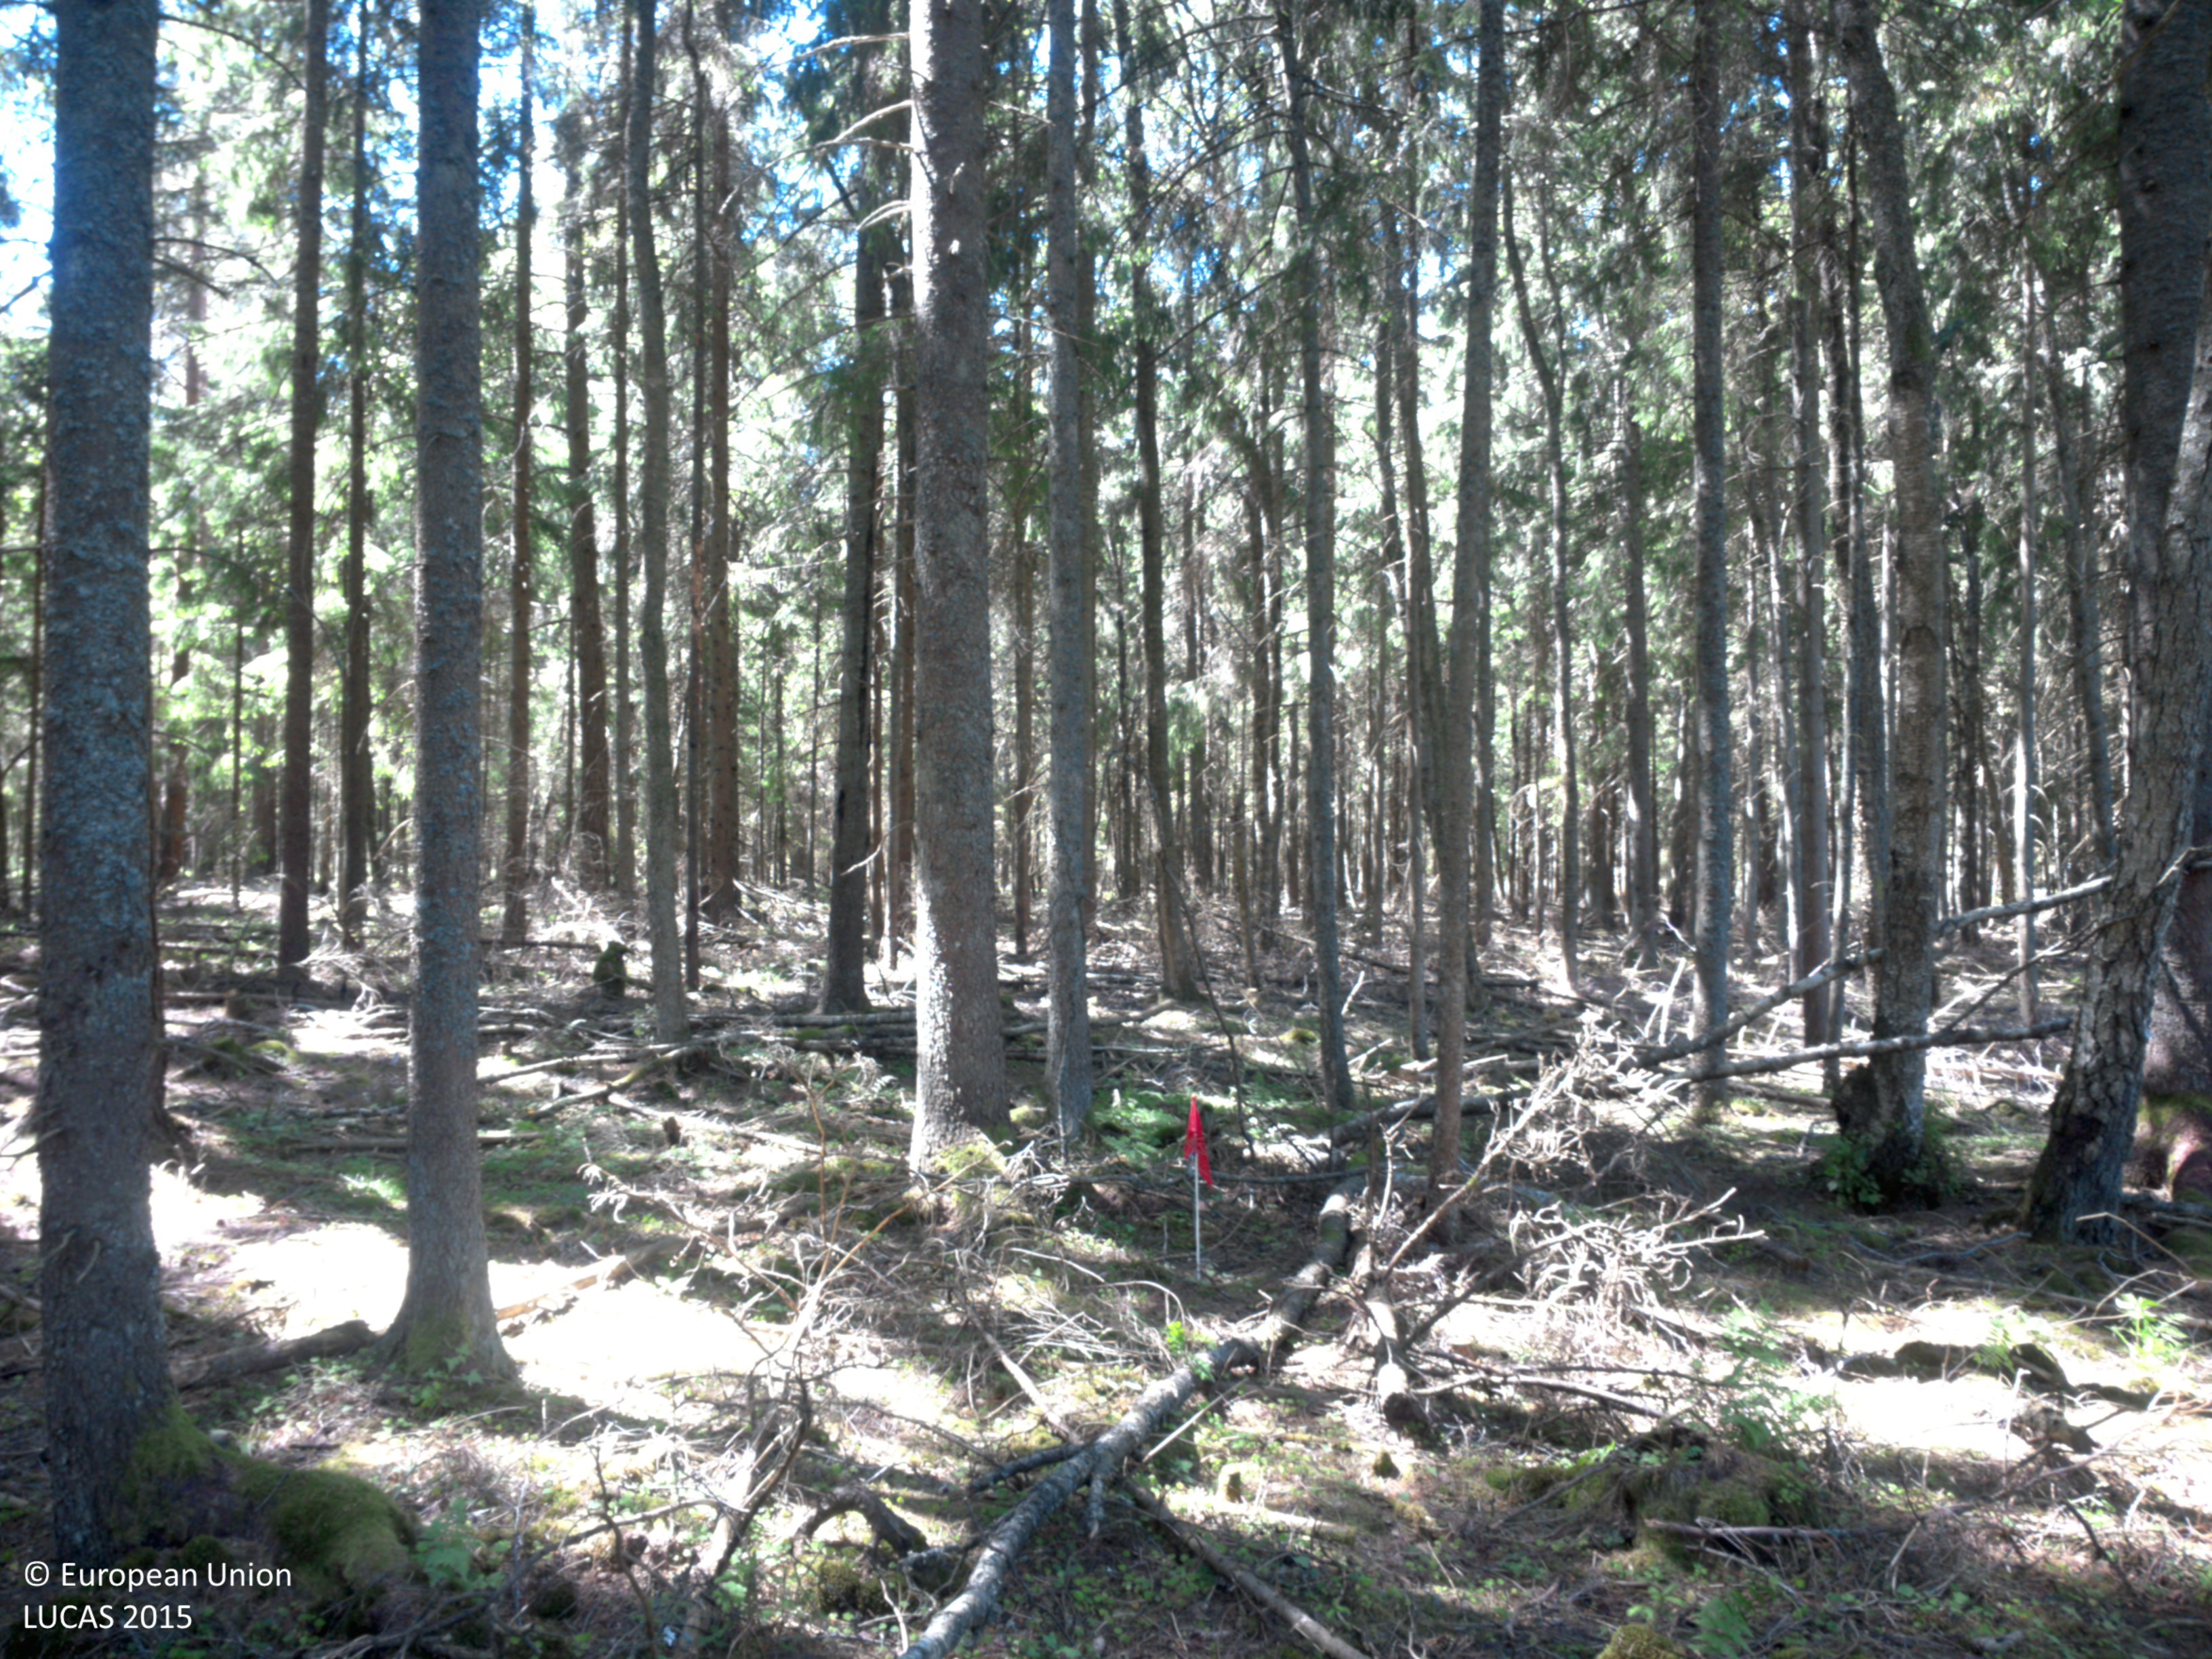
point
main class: Woodland
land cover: Spruce dominated coniferous woodland
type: boreal forest
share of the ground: > 75 %
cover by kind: coniferous forest trees 75 %, lichens and mosses 25 %
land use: Forestry
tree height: > 5 m
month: July
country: SE
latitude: 58.5114
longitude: 11.9356
